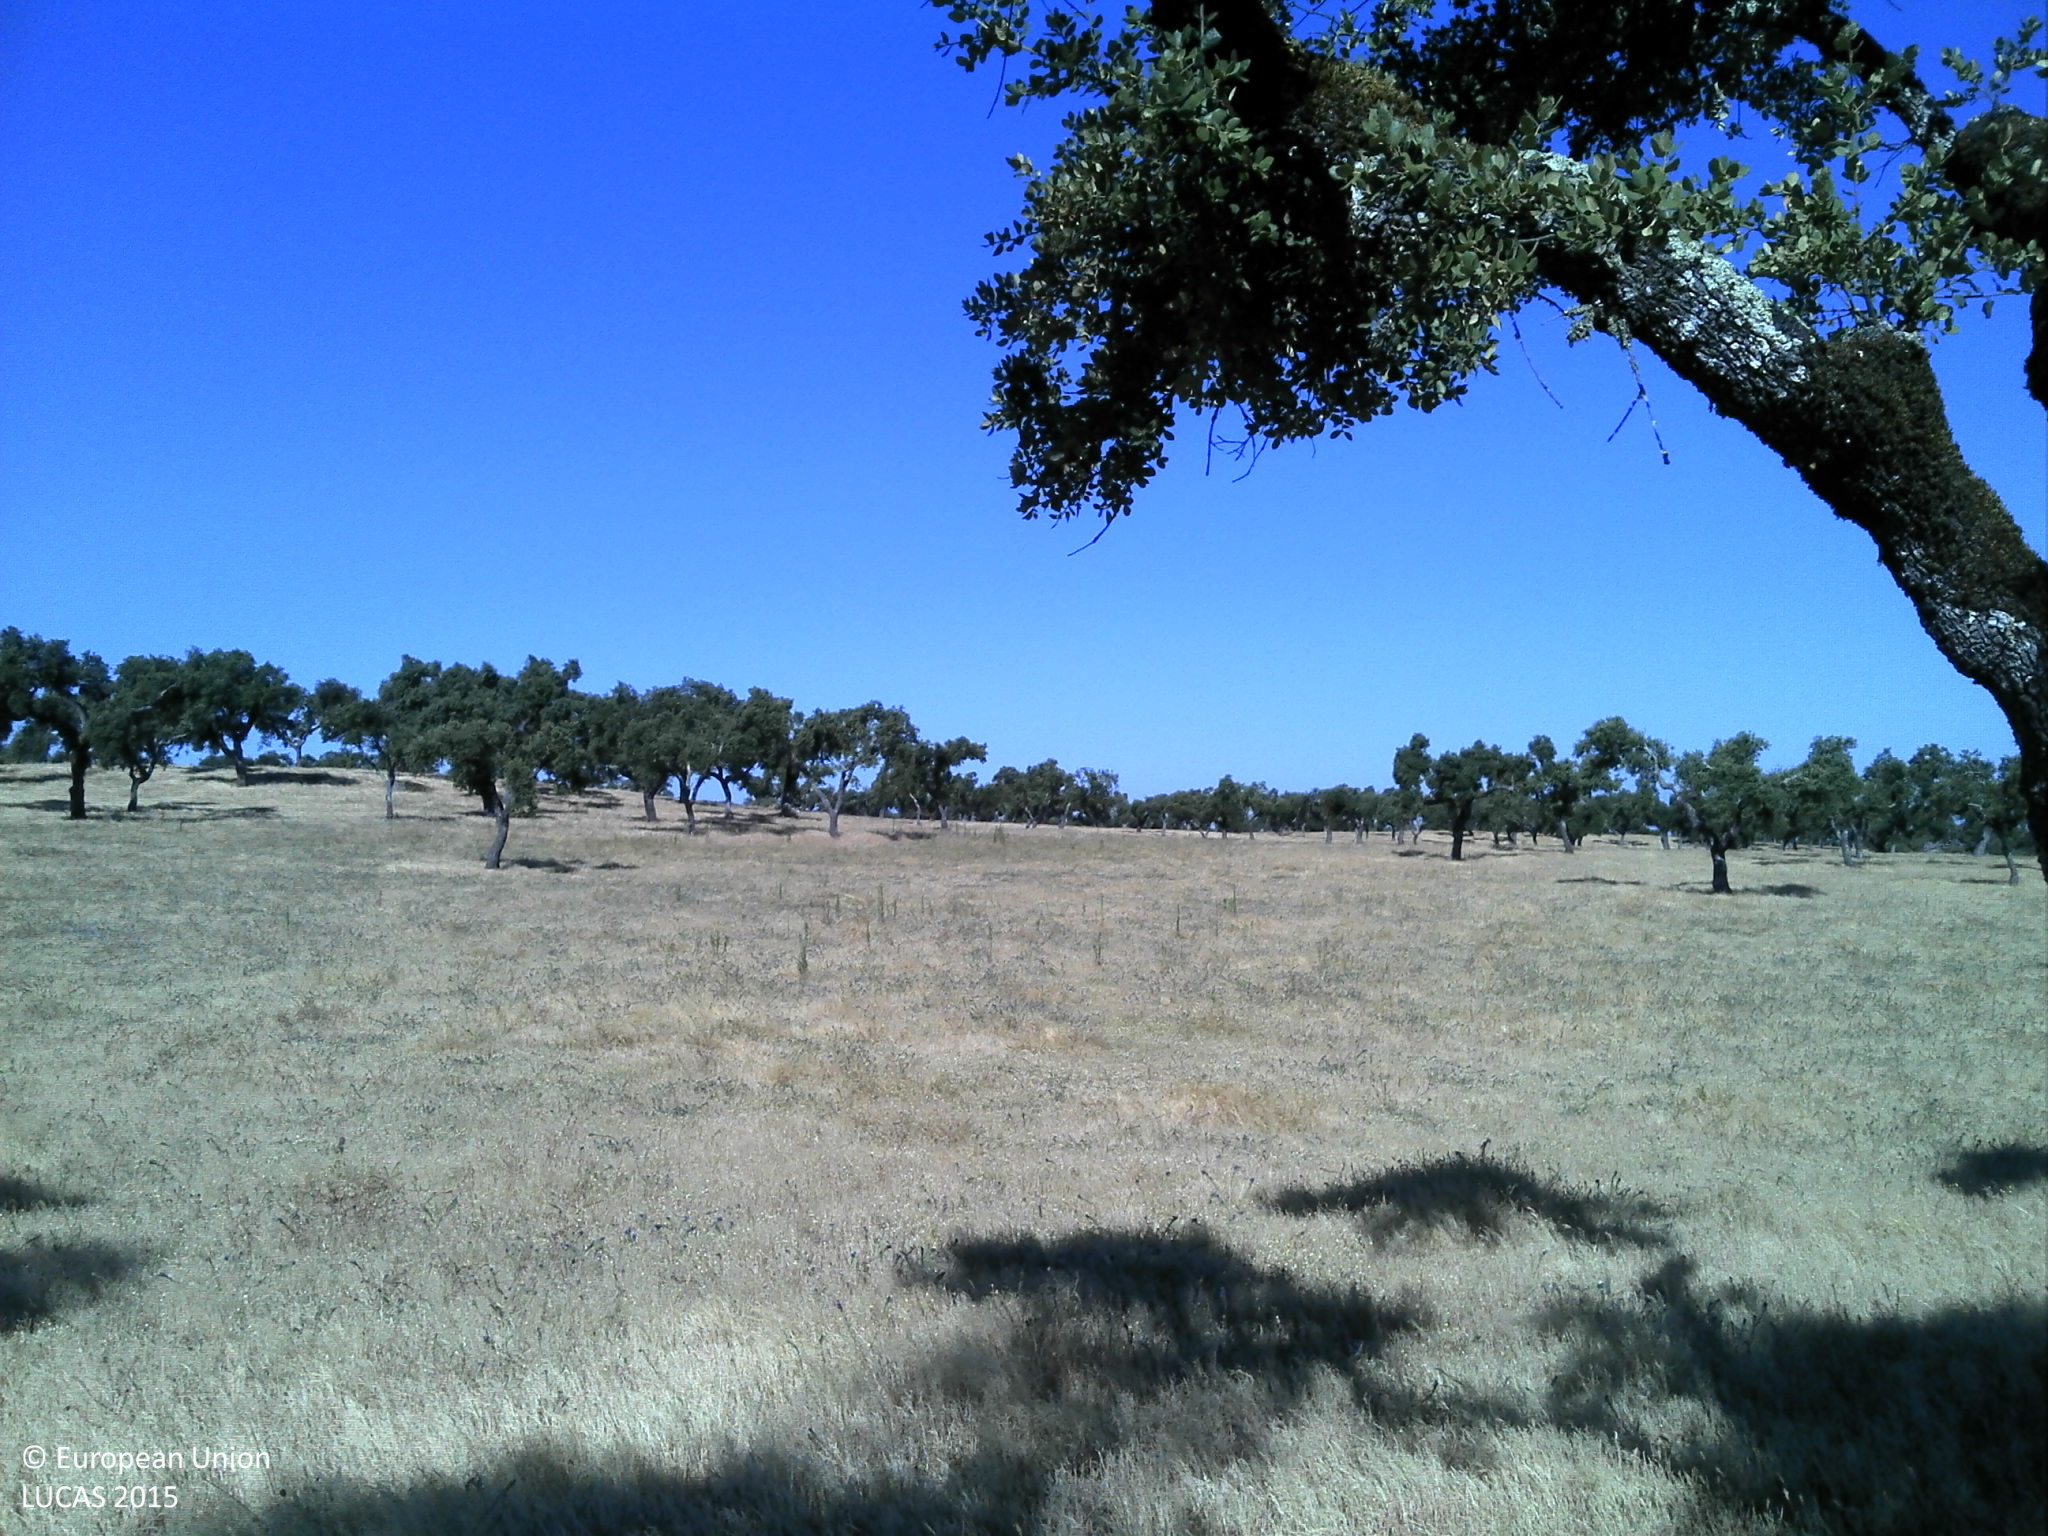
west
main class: Woodland
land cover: Broadleaved woodland
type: broadleaved evergreen forest
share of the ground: 25 - 50 %
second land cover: Grassland without tree/shrub cover
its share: 50 - 75 %
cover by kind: herbaceous plants 50 %, broadleaved forest trees 40 %, unconsolidated bare surface 10 %
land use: Forestry
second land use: Agriculture (excluding fallow land and kitchen gardens)
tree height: > 5 m
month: June
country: PT
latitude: 38.7704
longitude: -8.2012
